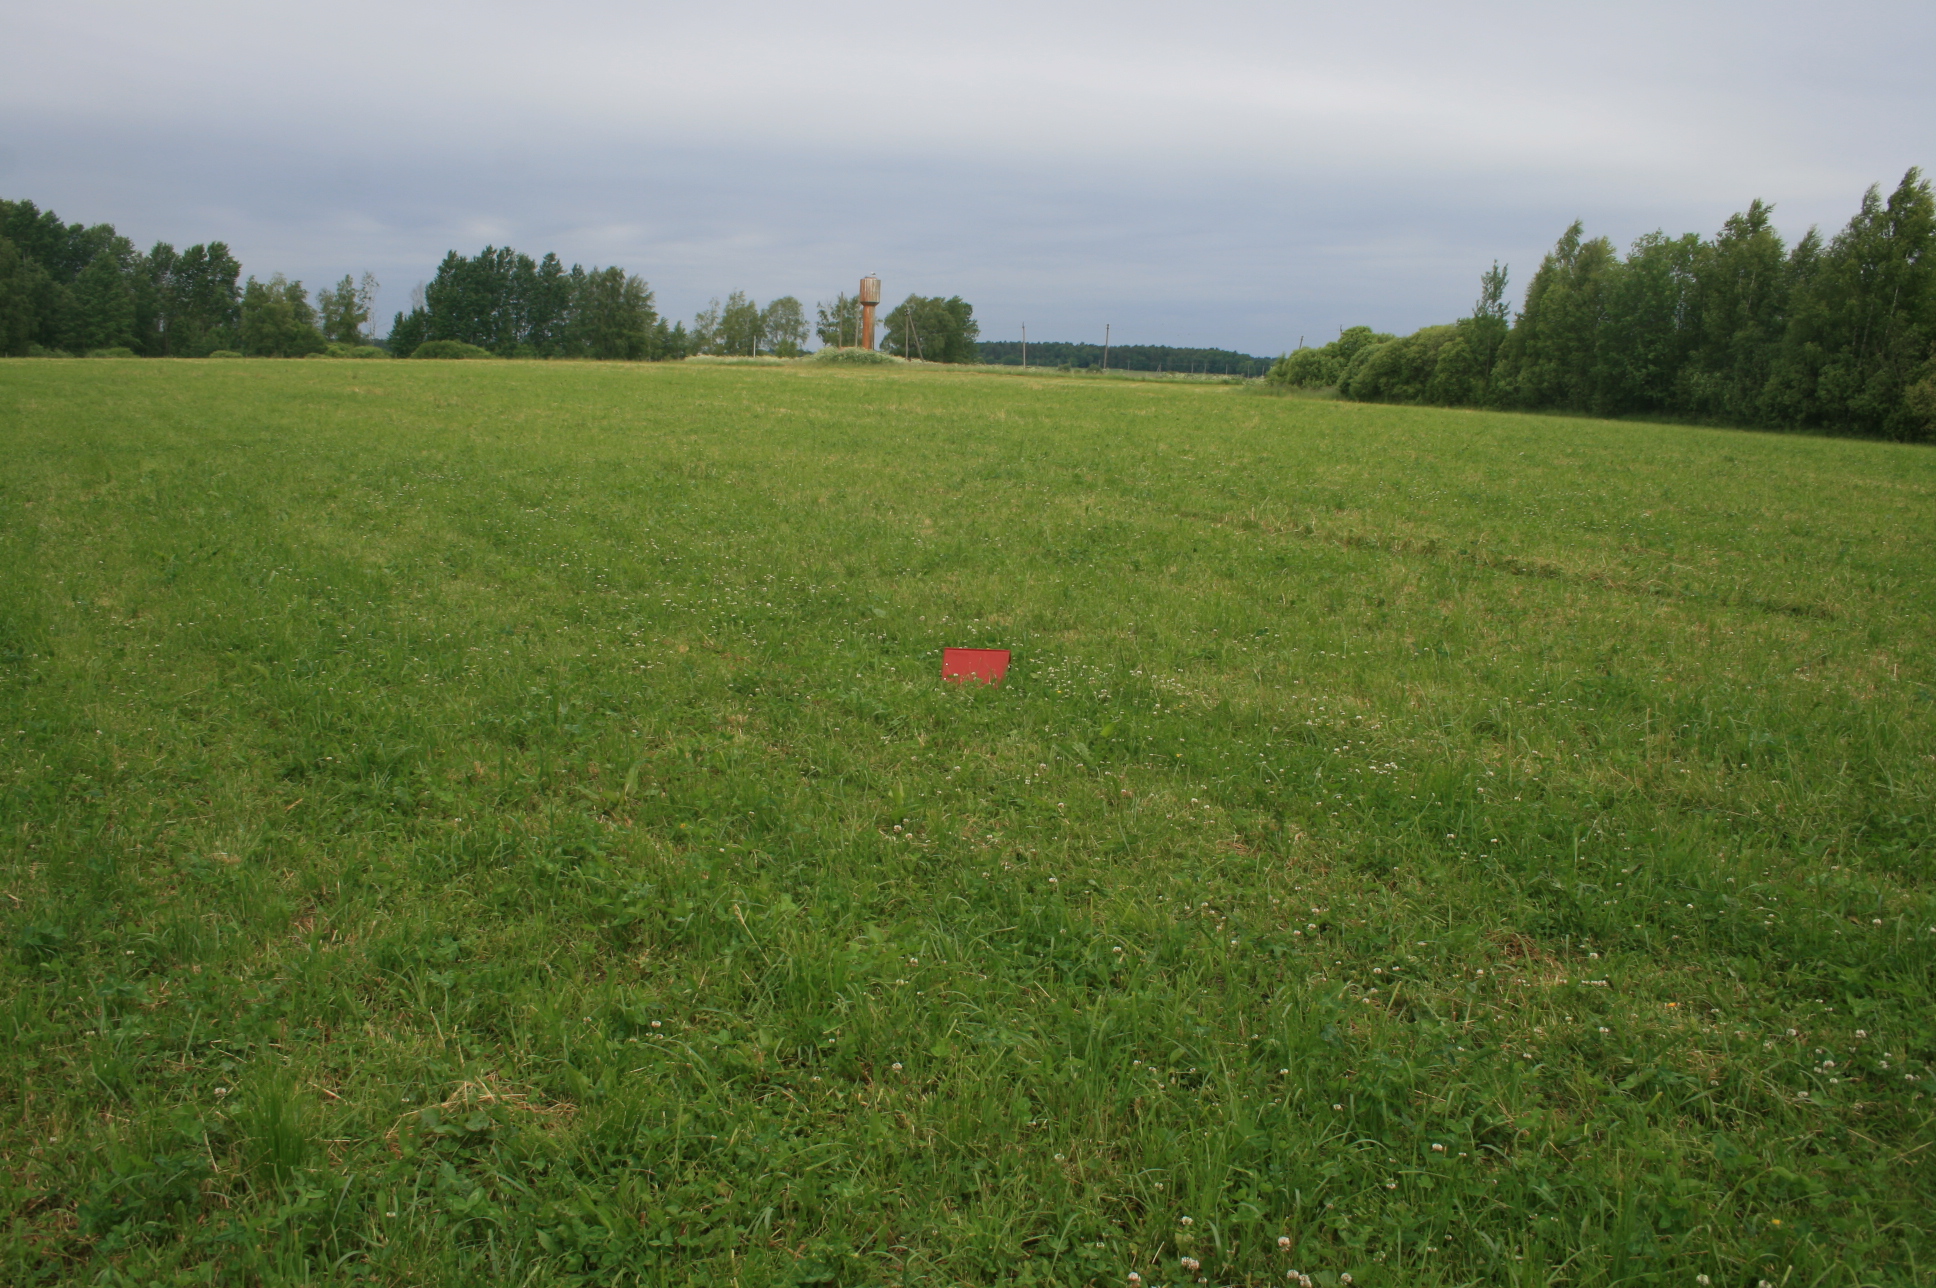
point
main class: Grassland
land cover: Grassland without tree/shrub cover
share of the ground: > 75 %
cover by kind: herbaceous plants 100 %
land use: Agriculture (excluding fallow land and kitchen gardens)
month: June
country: LT
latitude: 55.6555
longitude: 22.4082
